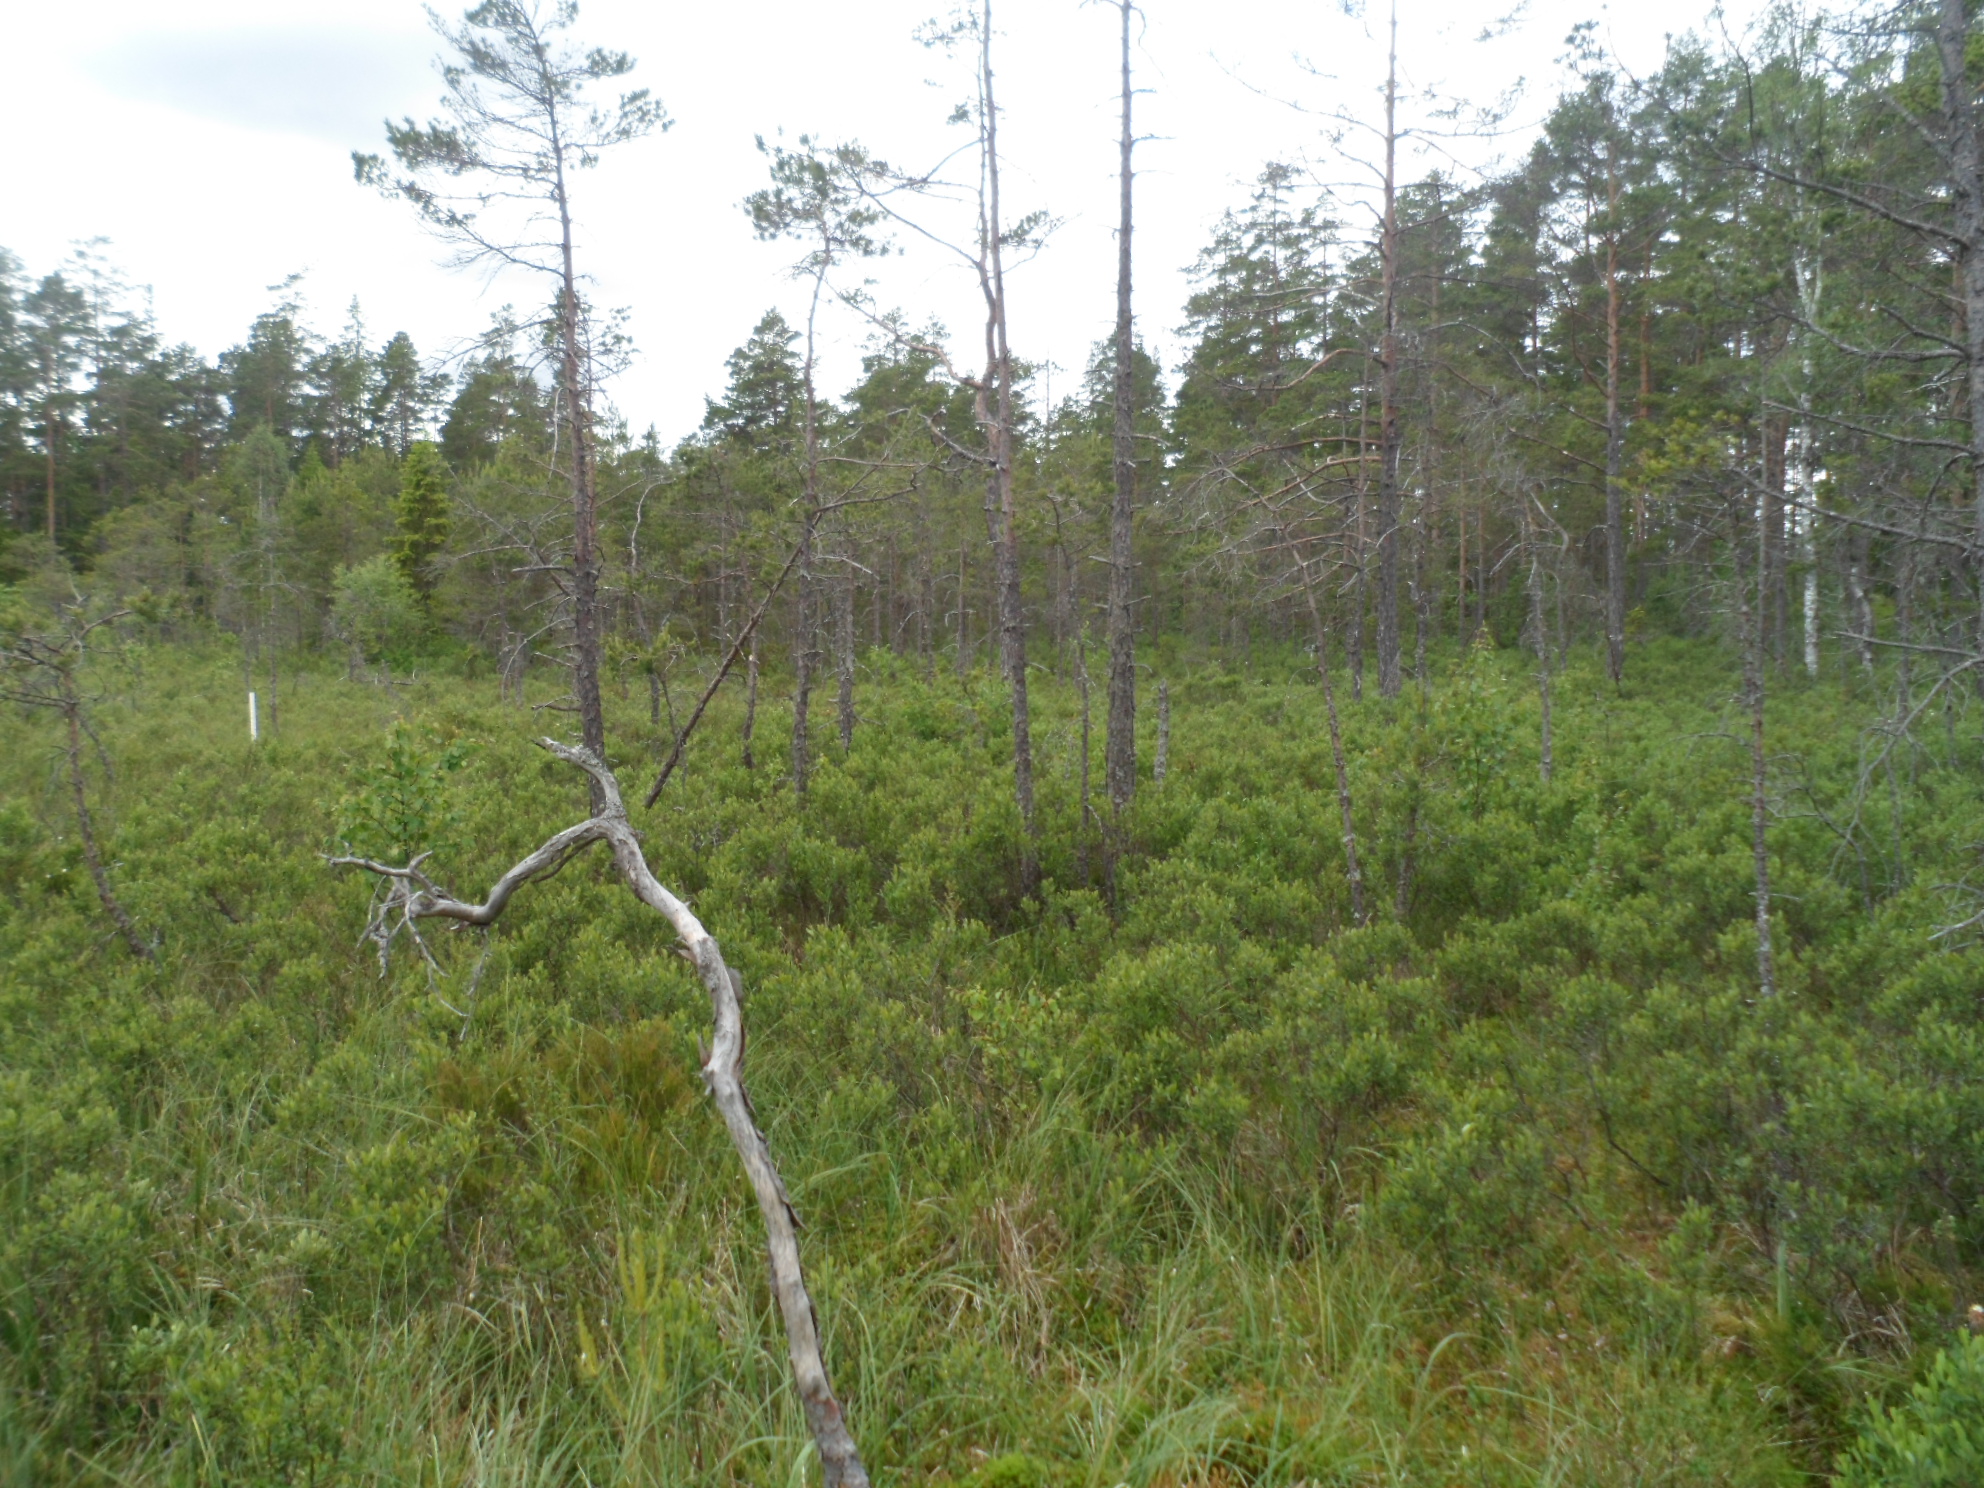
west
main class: Woodland
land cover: Pine dominated coniferous woodland
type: boreal forest
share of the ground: 25 - 50 %
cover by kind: shrubs 35 %, coniferous forest trees 25 %, herbaceous plants 20 %, lichens and mosses 15 %, broadleaved forest trees 5 %
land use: Forestry
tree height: > 5 m
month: June
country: SE
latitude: 56.9349
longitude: 15.5035
